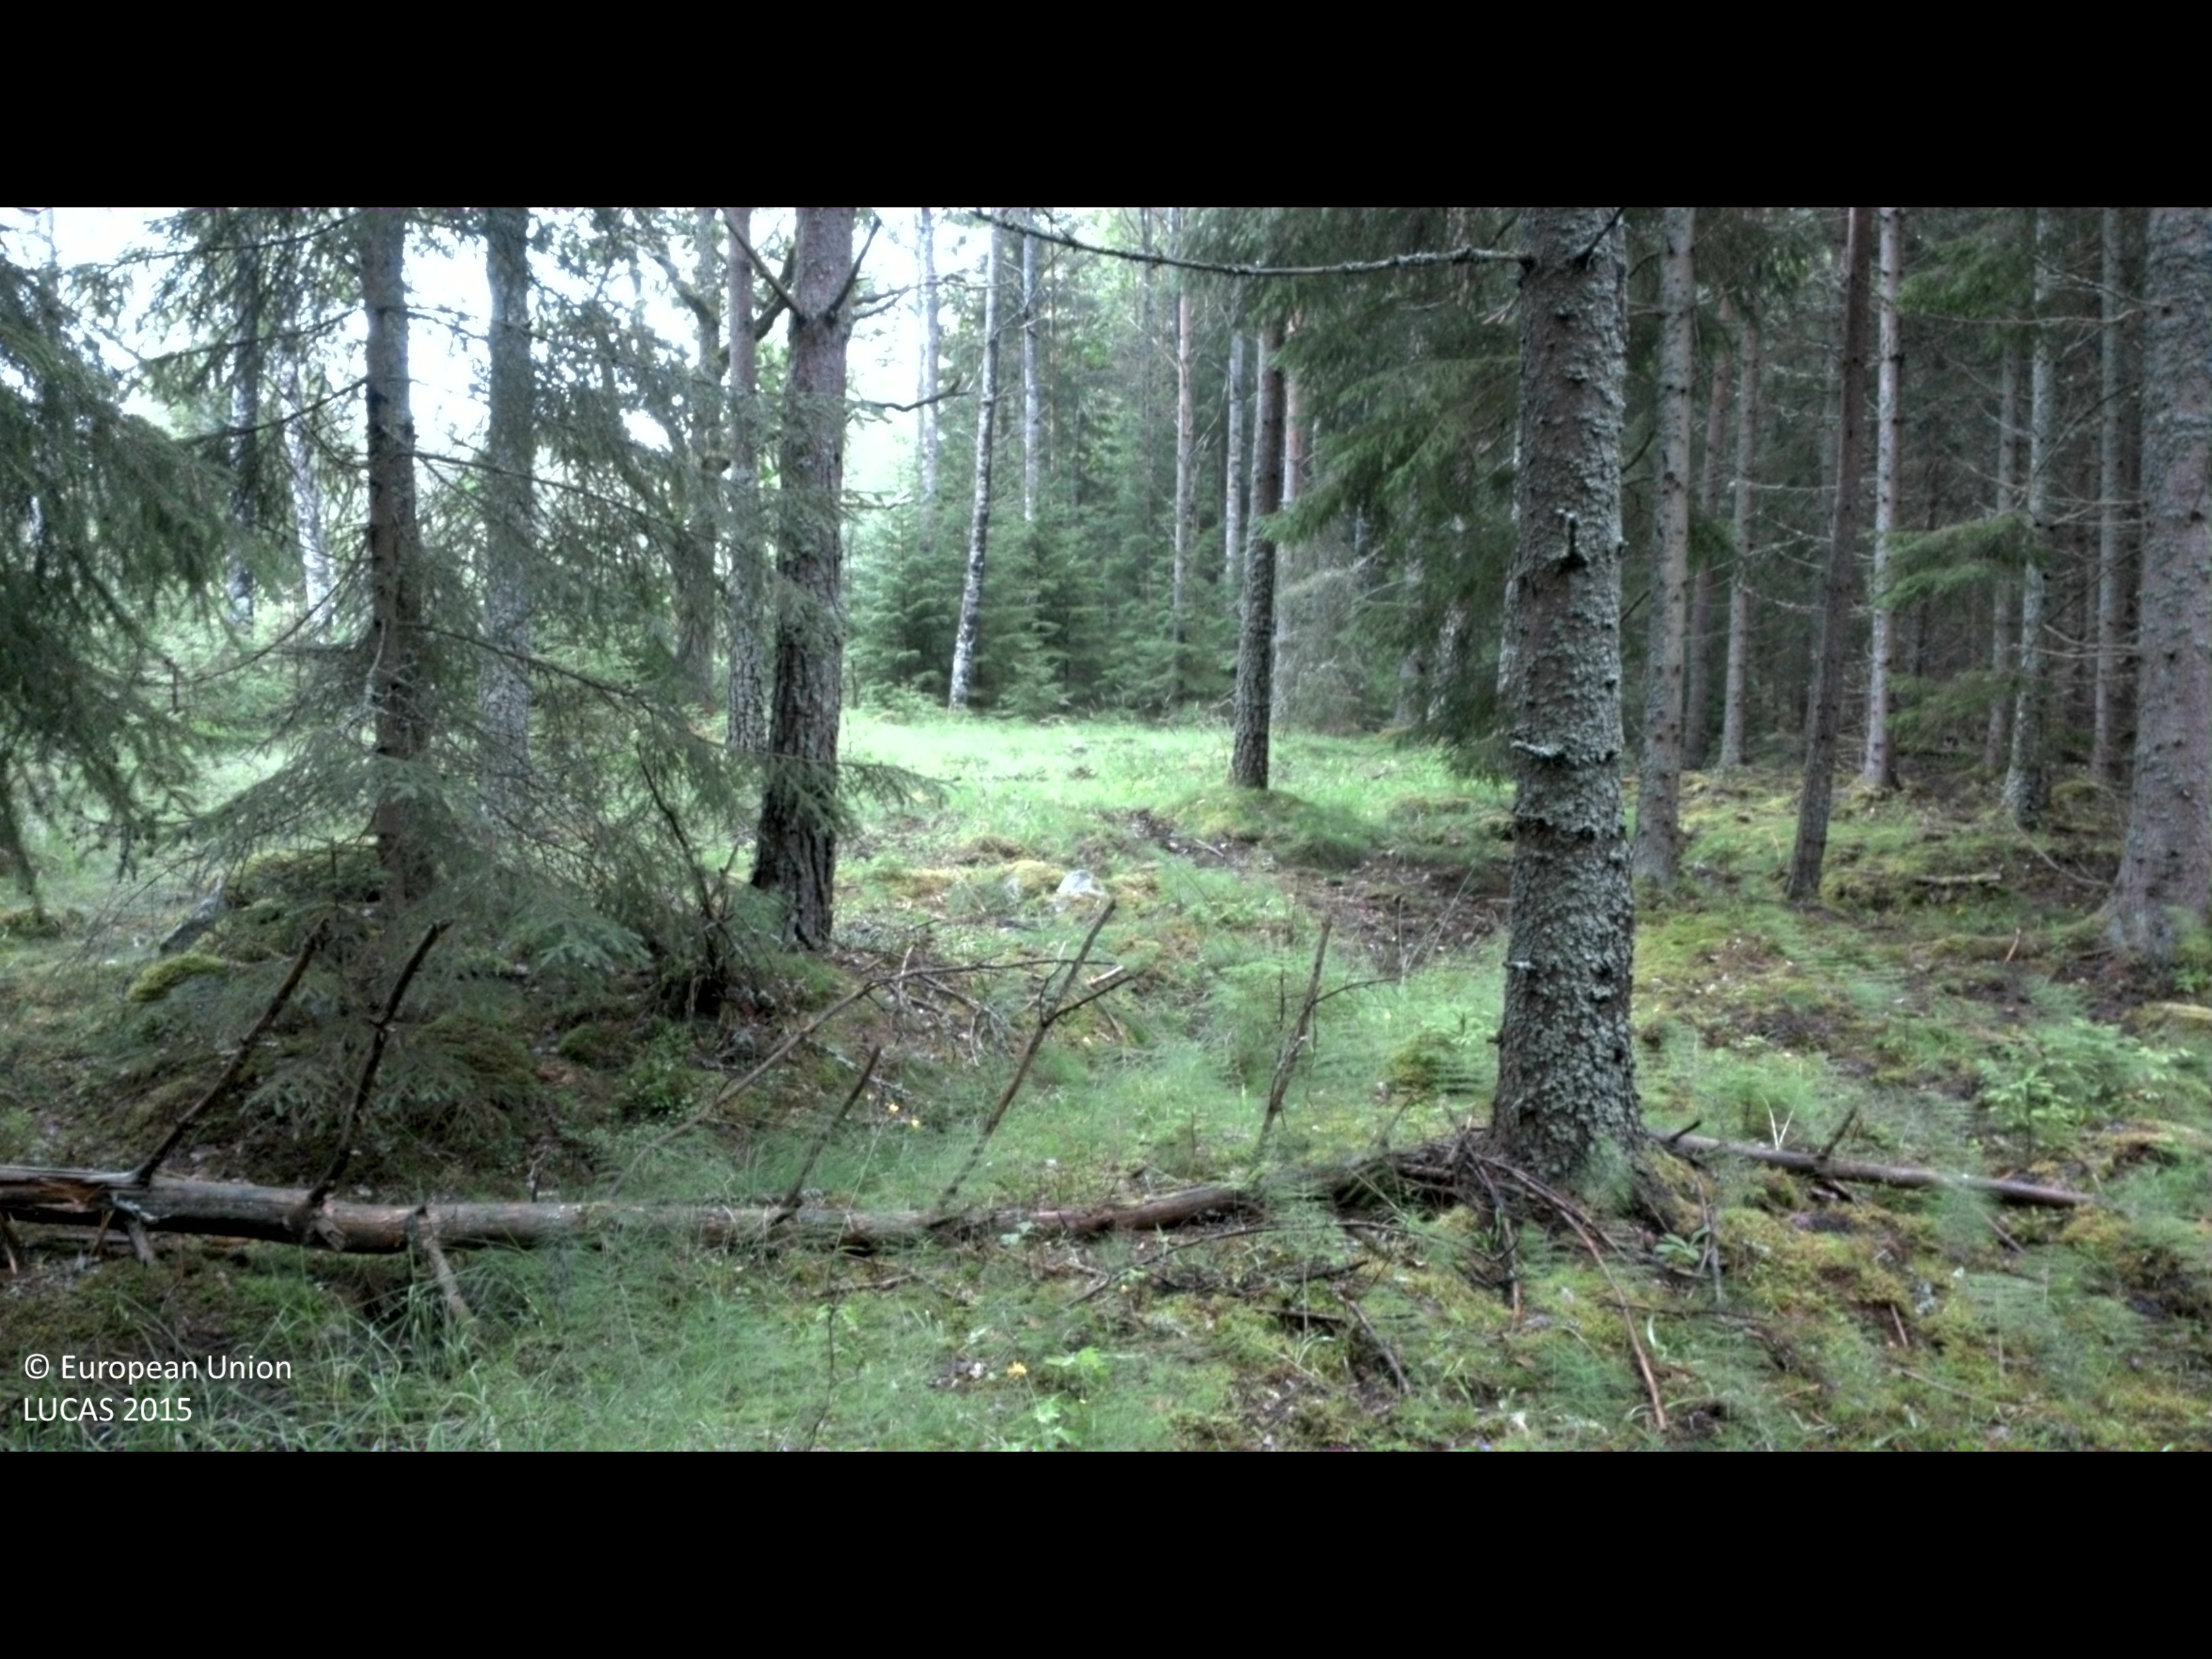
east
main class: Woodland
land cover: Spruce dominated coniferous woodland
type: boreal forest
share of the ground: 50 - 75 %
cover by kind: coniferous forest trees 60 %, herbaceous plants 20 %, lichens and mosses 15 %, shrubs 5 %
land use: Forestry
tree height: > 5 m
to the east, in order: Spruce dominated coniferous woodland; Broadleaved woodland; Other mixed woodland; Spruce dominated mixed woodland; Pine dominated coniferous woodland
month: July
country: SE
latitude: 58.3488
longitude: 16.1638
